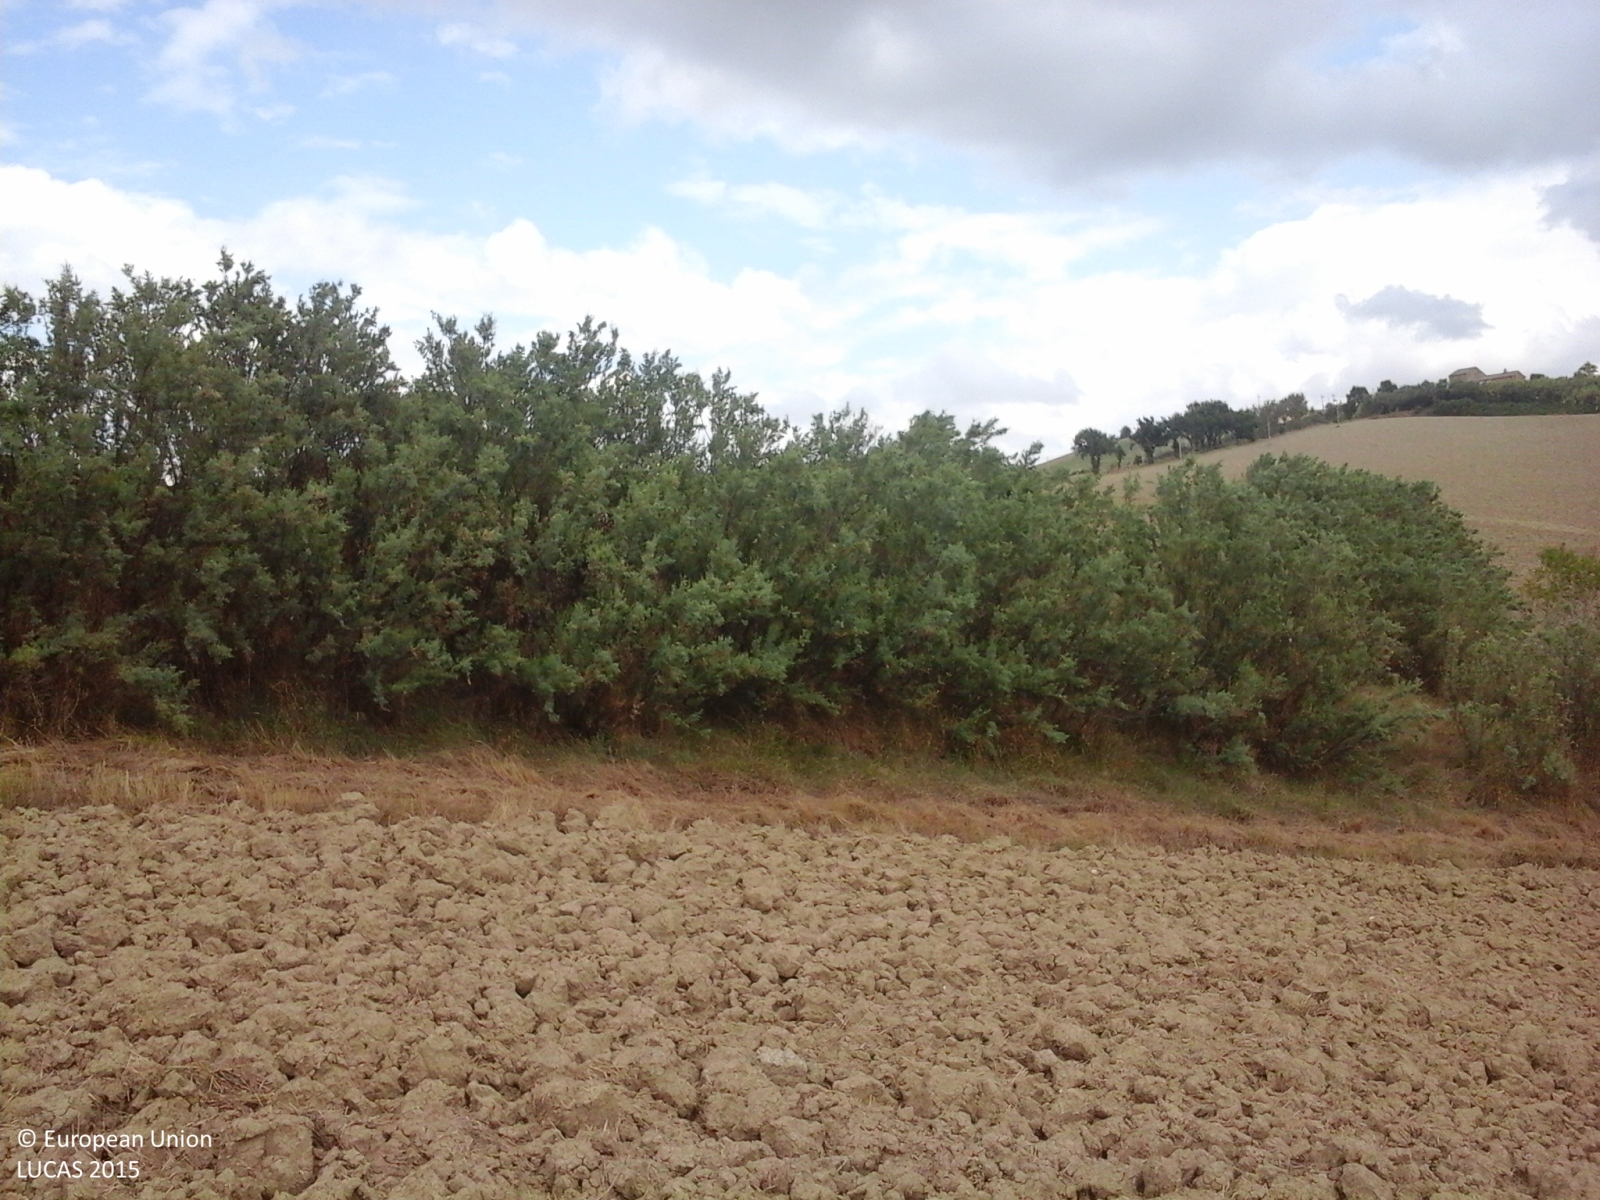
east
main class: Cropland
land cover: Durum wheat
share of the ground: < 10 %
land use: Agriculture (excluding fallow land and kitchen gardens)
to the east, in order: Durum wheat; Grass margins; Abandoned hedges; Fences; Durum wheat; Olive groves; Artificial constructions in urban areas
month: August
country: IT
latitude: 43.4866
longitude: 13.2685
